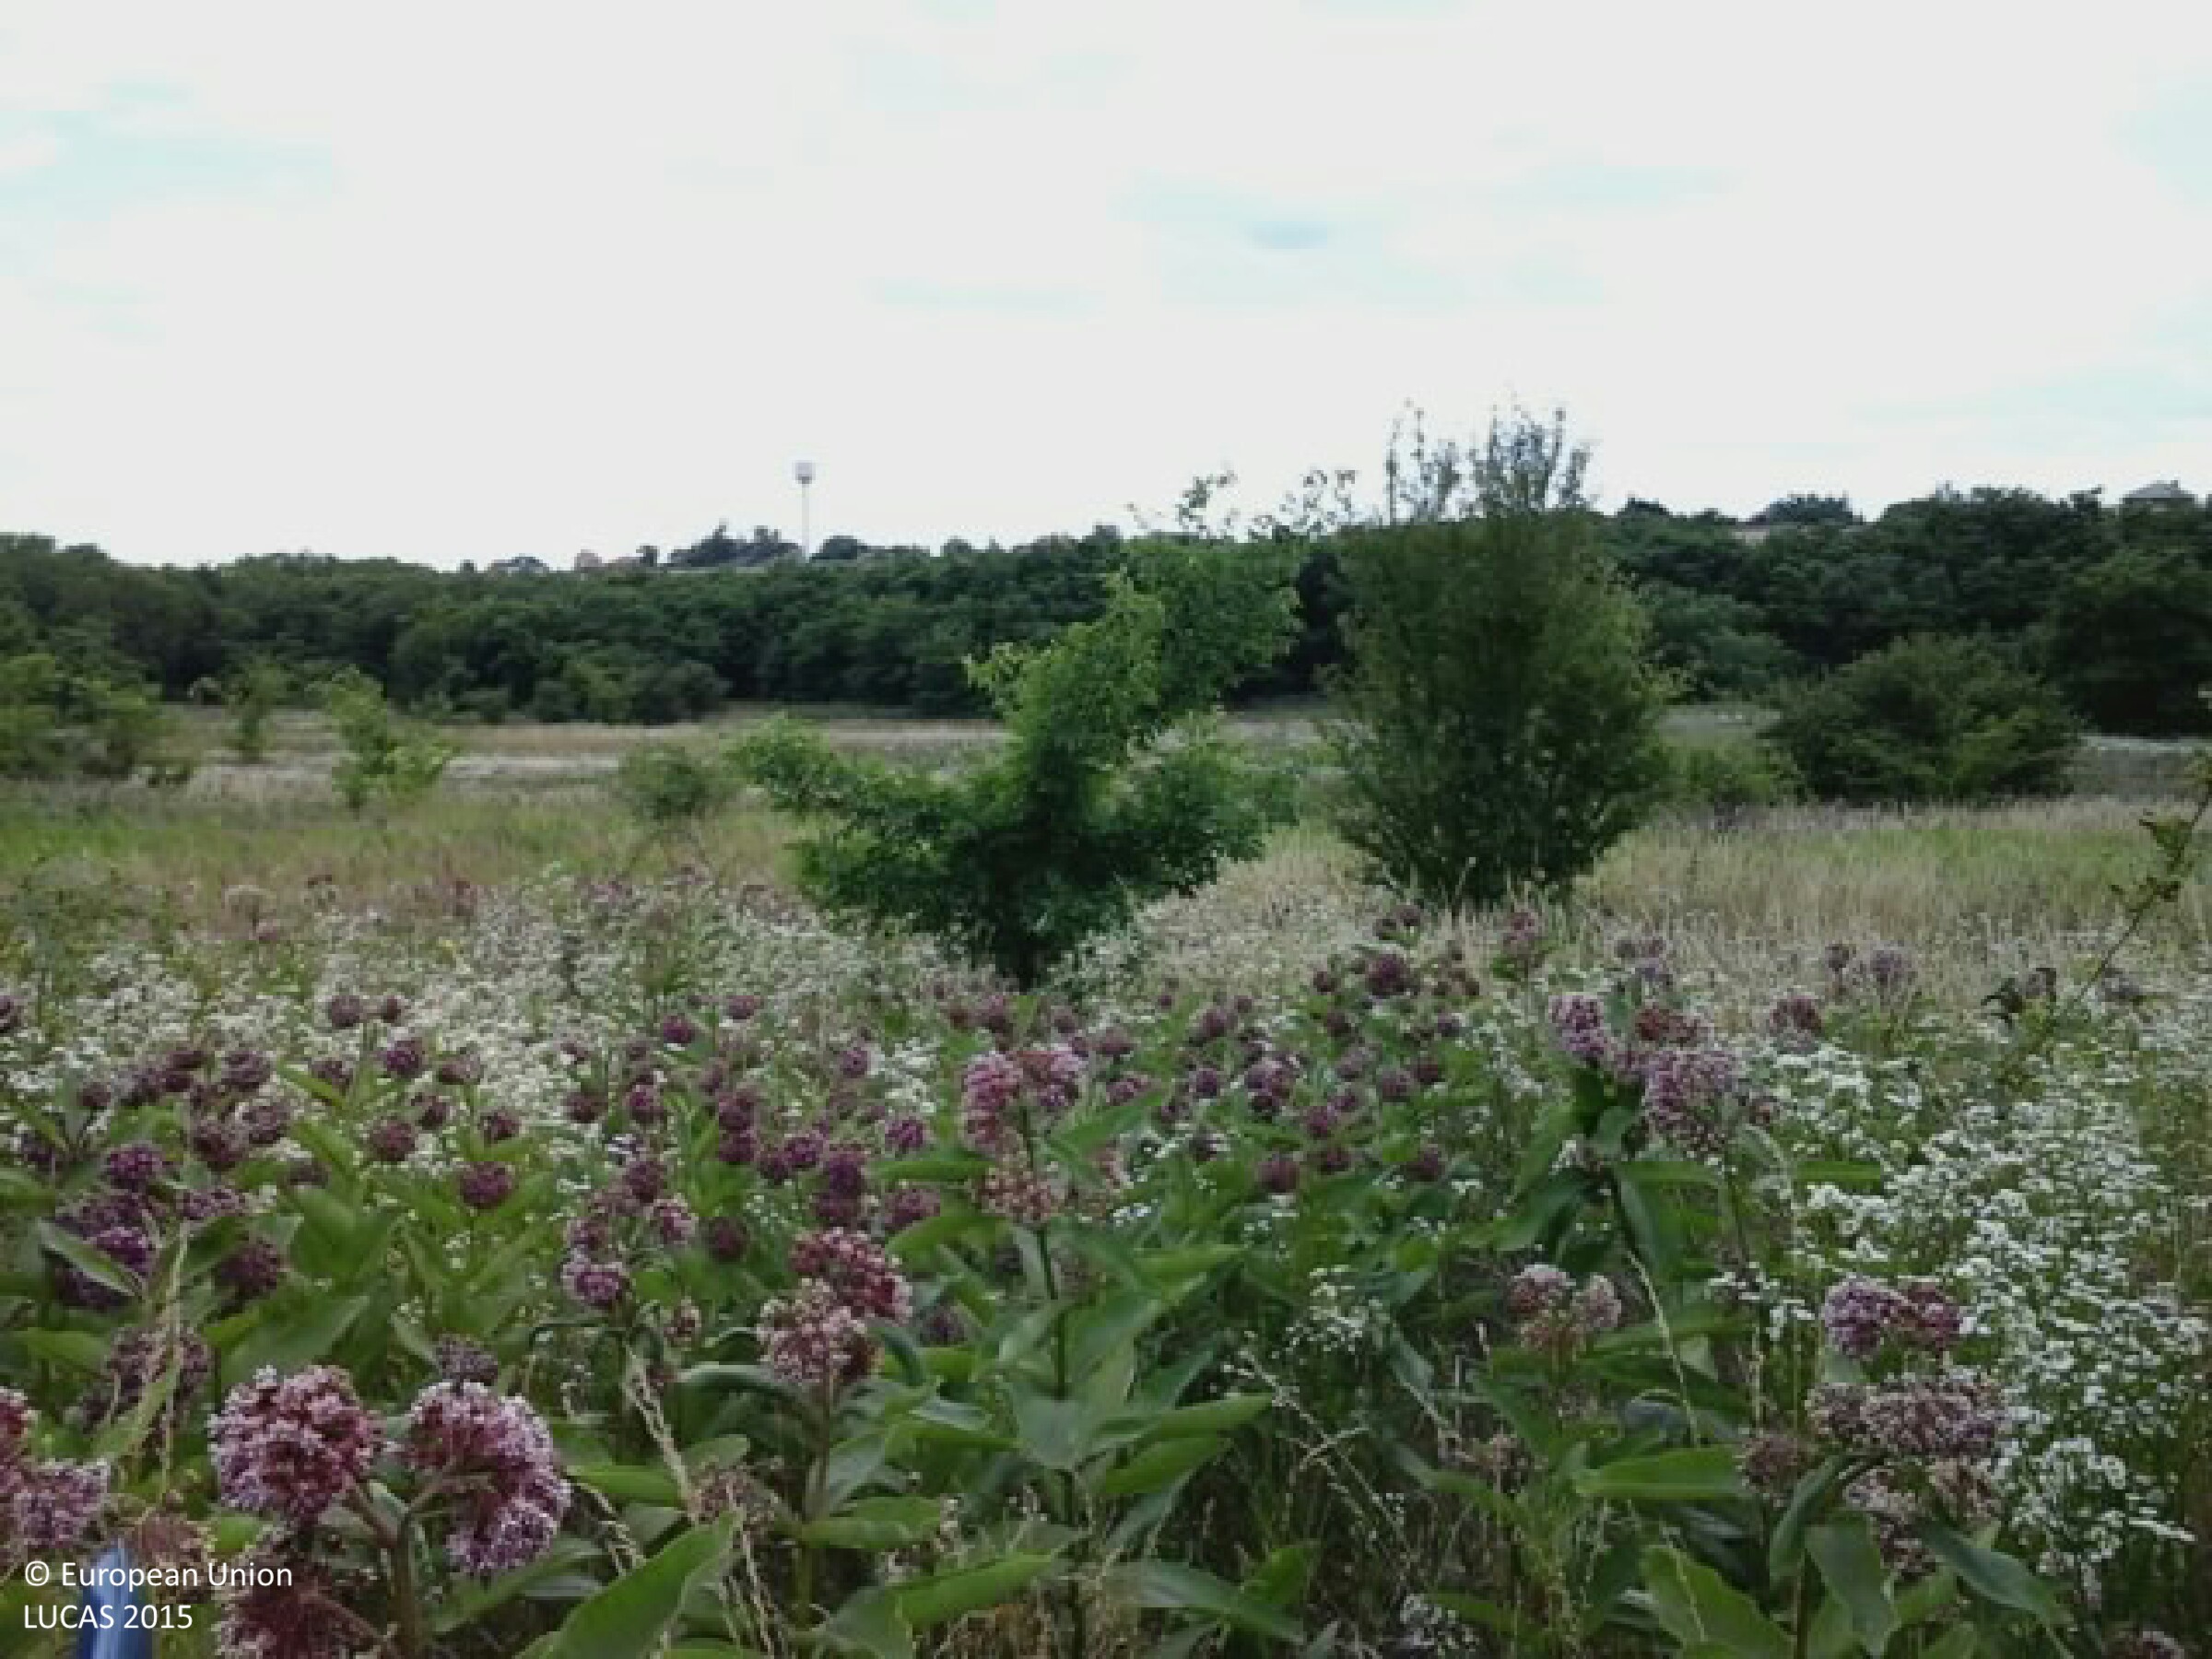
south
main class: Grassland
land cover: Grassland with sparse tree/shrub cover
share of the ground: > 75 %
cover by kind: herbaceous plants 85 %, shrubs 10 %, broadleaved forest trees 5 %
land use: Semi-natural and natural areas not in use
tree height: < 5 m
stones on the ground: 10 - 25 %
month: June
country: HU
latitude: 47.5639
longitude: 19.2303
